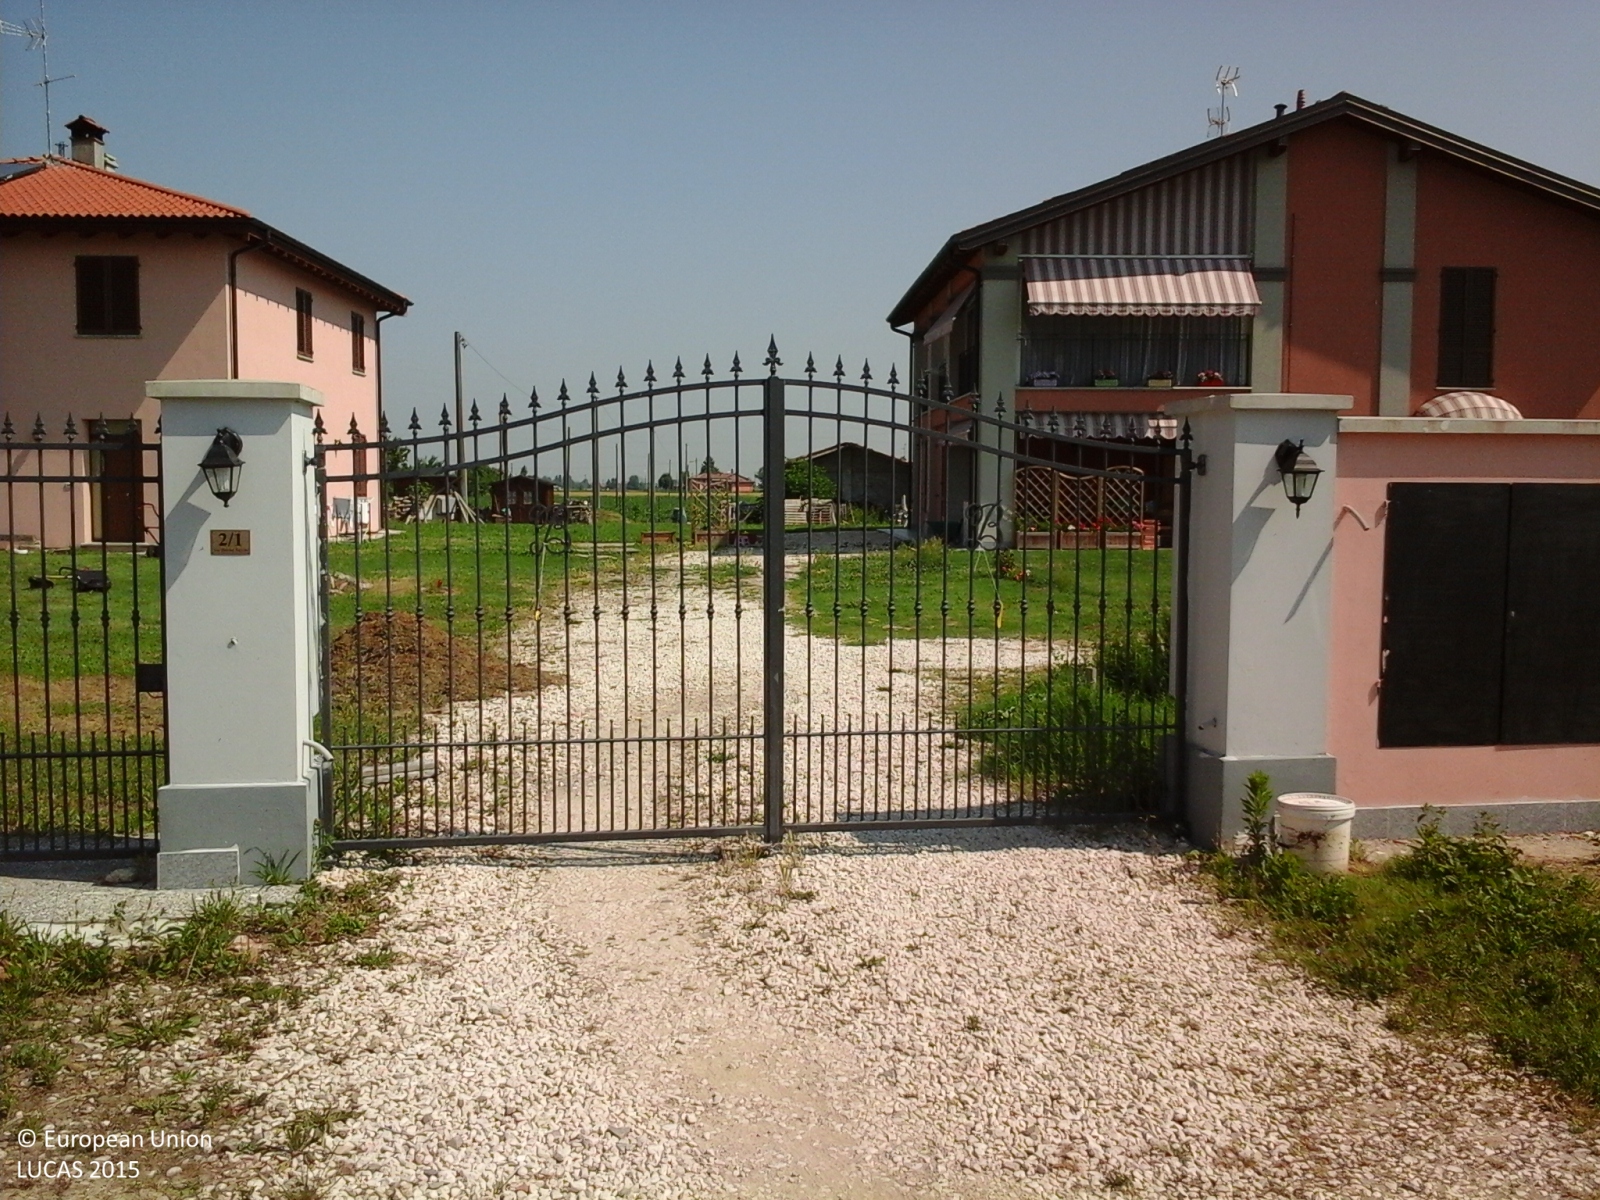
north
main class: Grassland
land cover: Grassland without tree/shrub cover
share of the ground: > 75 %
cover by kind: herbaceous plants 100 %
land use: Residential
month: June
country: IT
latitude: 44.5601
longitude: 11.1935
